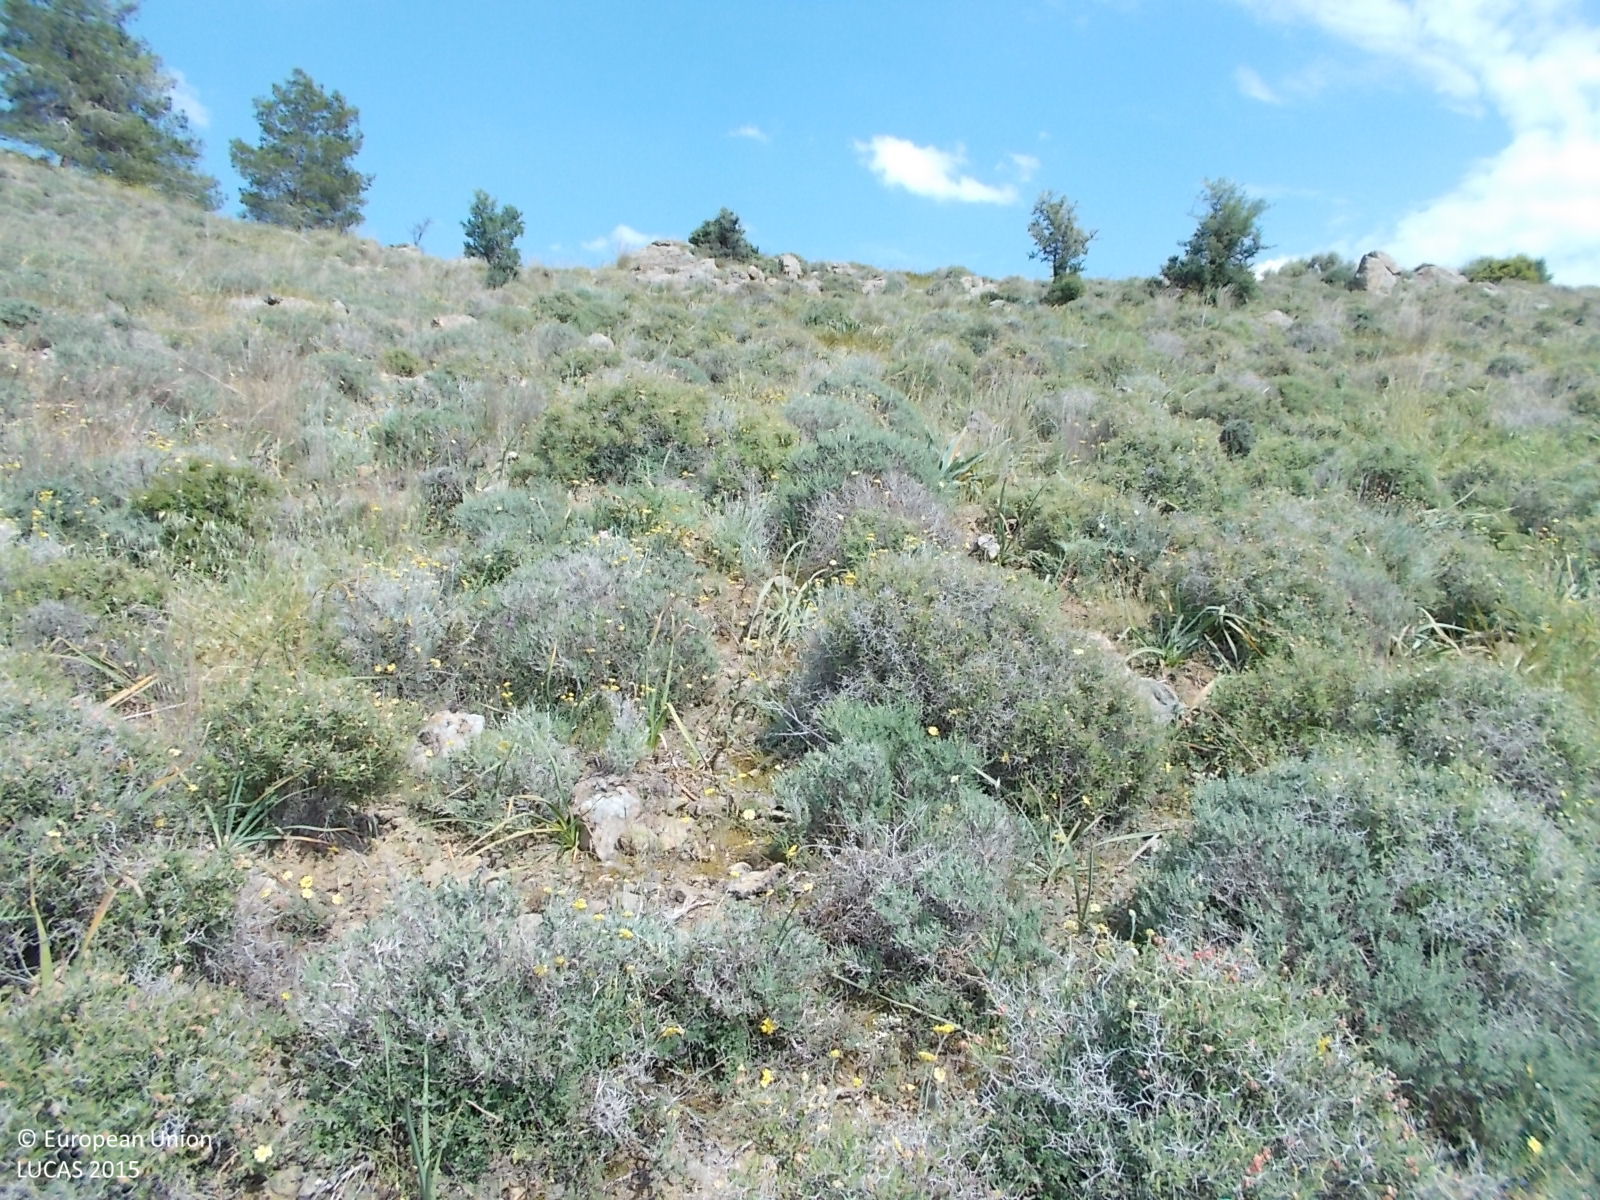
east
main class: Shrubland
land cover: Shrubland without tree cover
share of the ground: > 75 %
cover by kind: shrubs 75 %, herbaceous plants 15 %, unconsolidated bare surface 10 %
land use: Semi-natural and natural areas not in use
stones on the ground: 25 - 50 %
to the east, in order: Shrubland without tree cover; Shrubland with sparse tree cover; Tracks; Shrubland without tree cover; Artificial constructions in urban areas; Grassland without tree/shrub cover; Single bushes/trees; Grassland without tree/shrub cover; Tracks; Grassland without tree/shrub cover; Rivers and streams; Abandoned hedges; Spontaneously vegetated surfaces
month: April
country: CY
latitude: 34.9562
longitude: 33.4616
